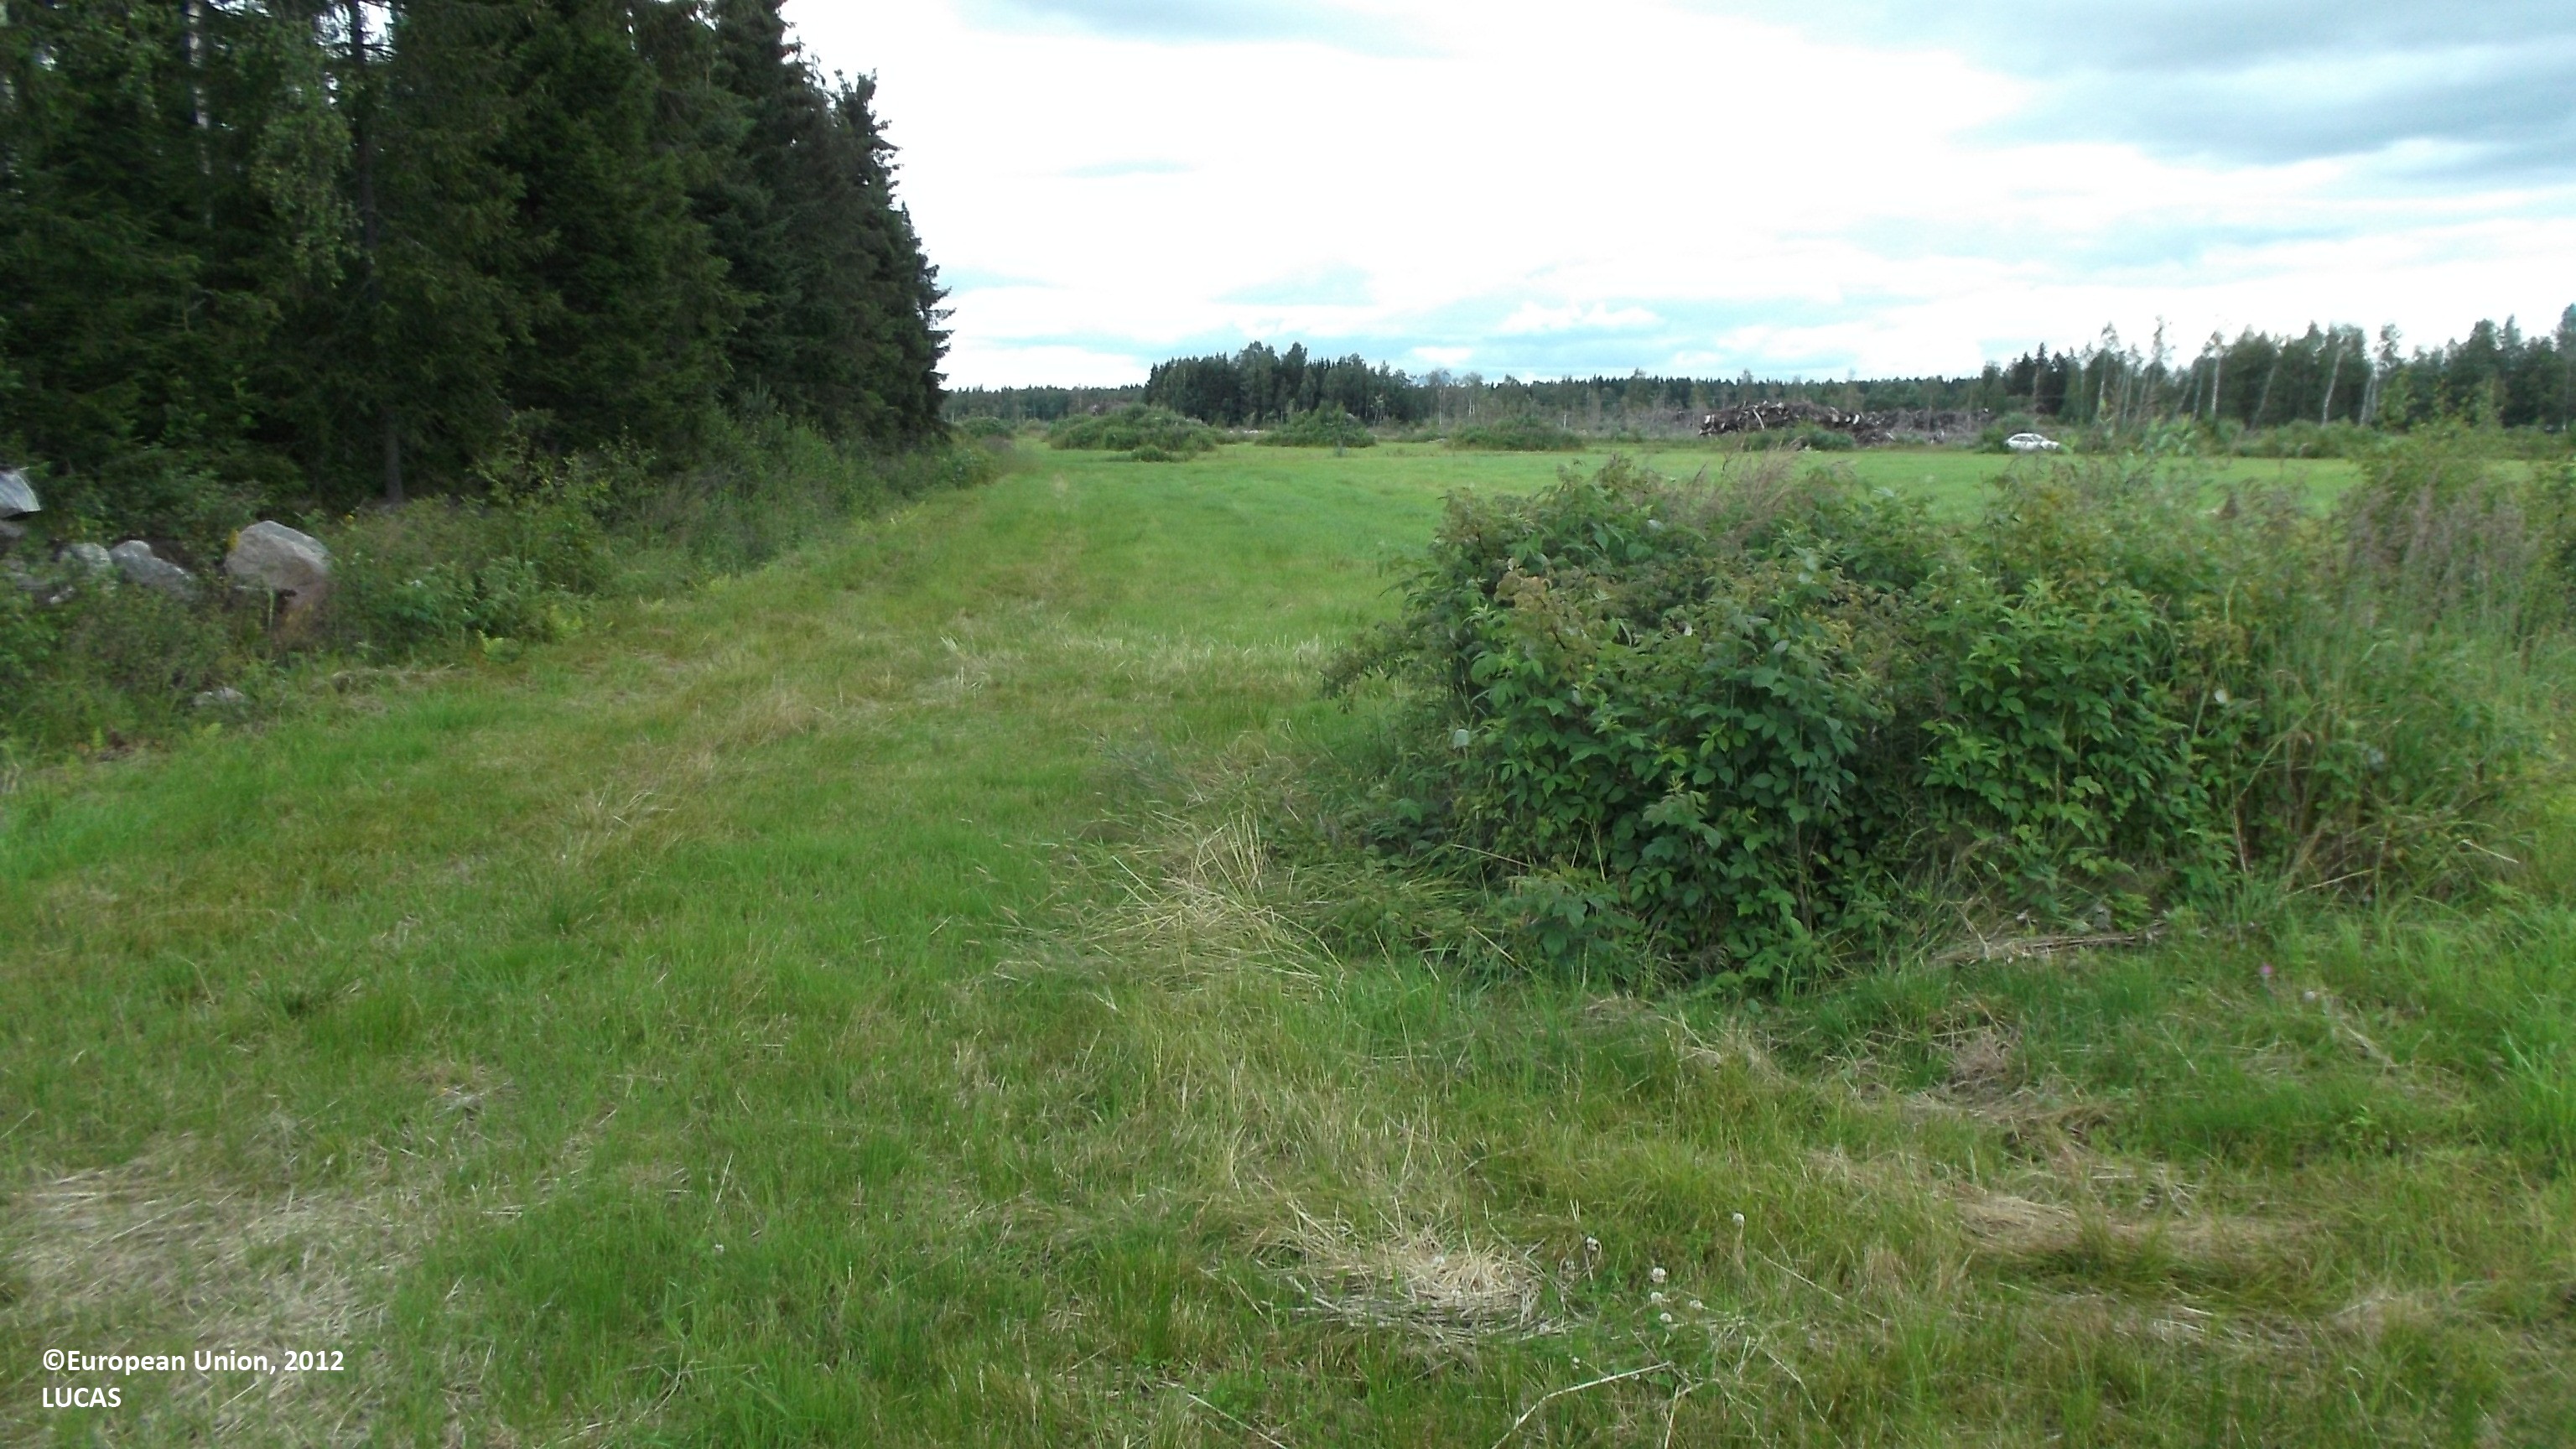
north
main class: Cropland
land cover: Temporary grasslands
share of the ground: > 75 %
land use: Agriculture (excluding fallow land and kitchen gardens)
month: July
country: FI
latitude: 63.6774
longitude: 23.2145
